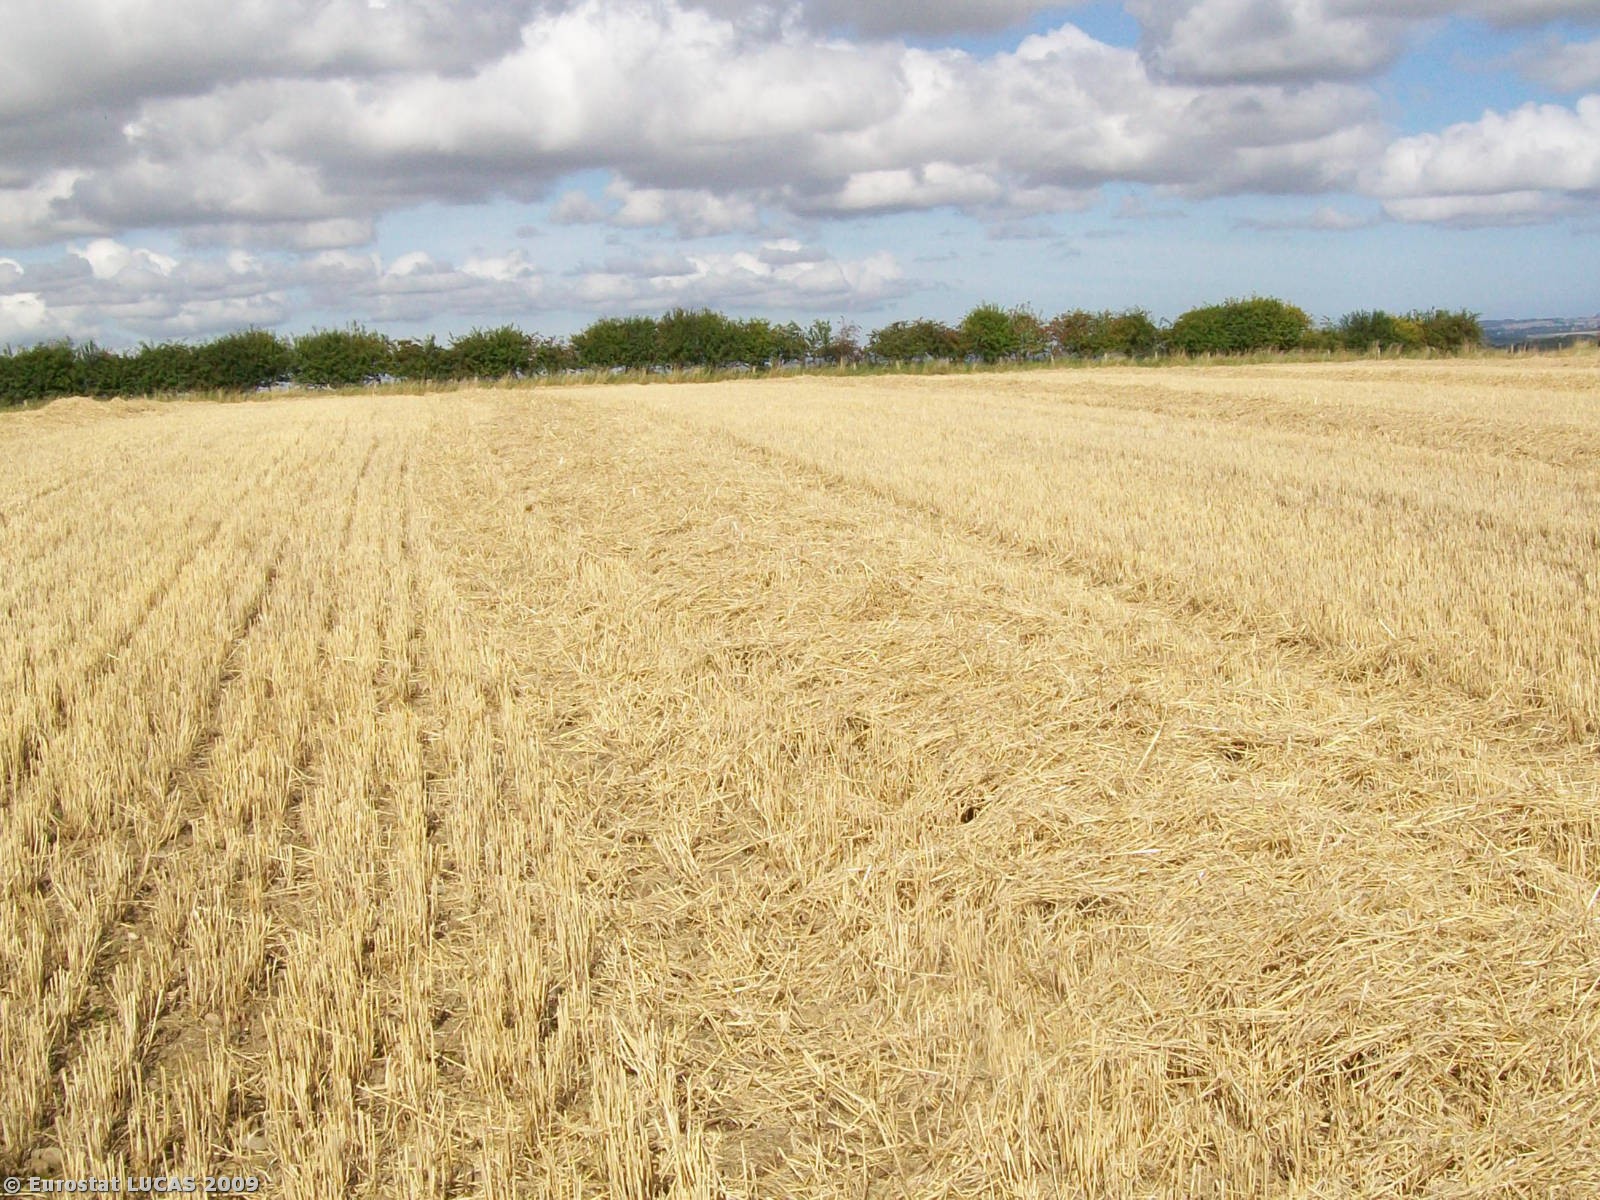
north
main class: Cropland
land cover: Barley
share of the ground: > 75 %
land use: Agriculture (excluding fallow land and kitchen gardens)
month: September
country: GB
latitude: 55.6592
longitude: -2.1832
